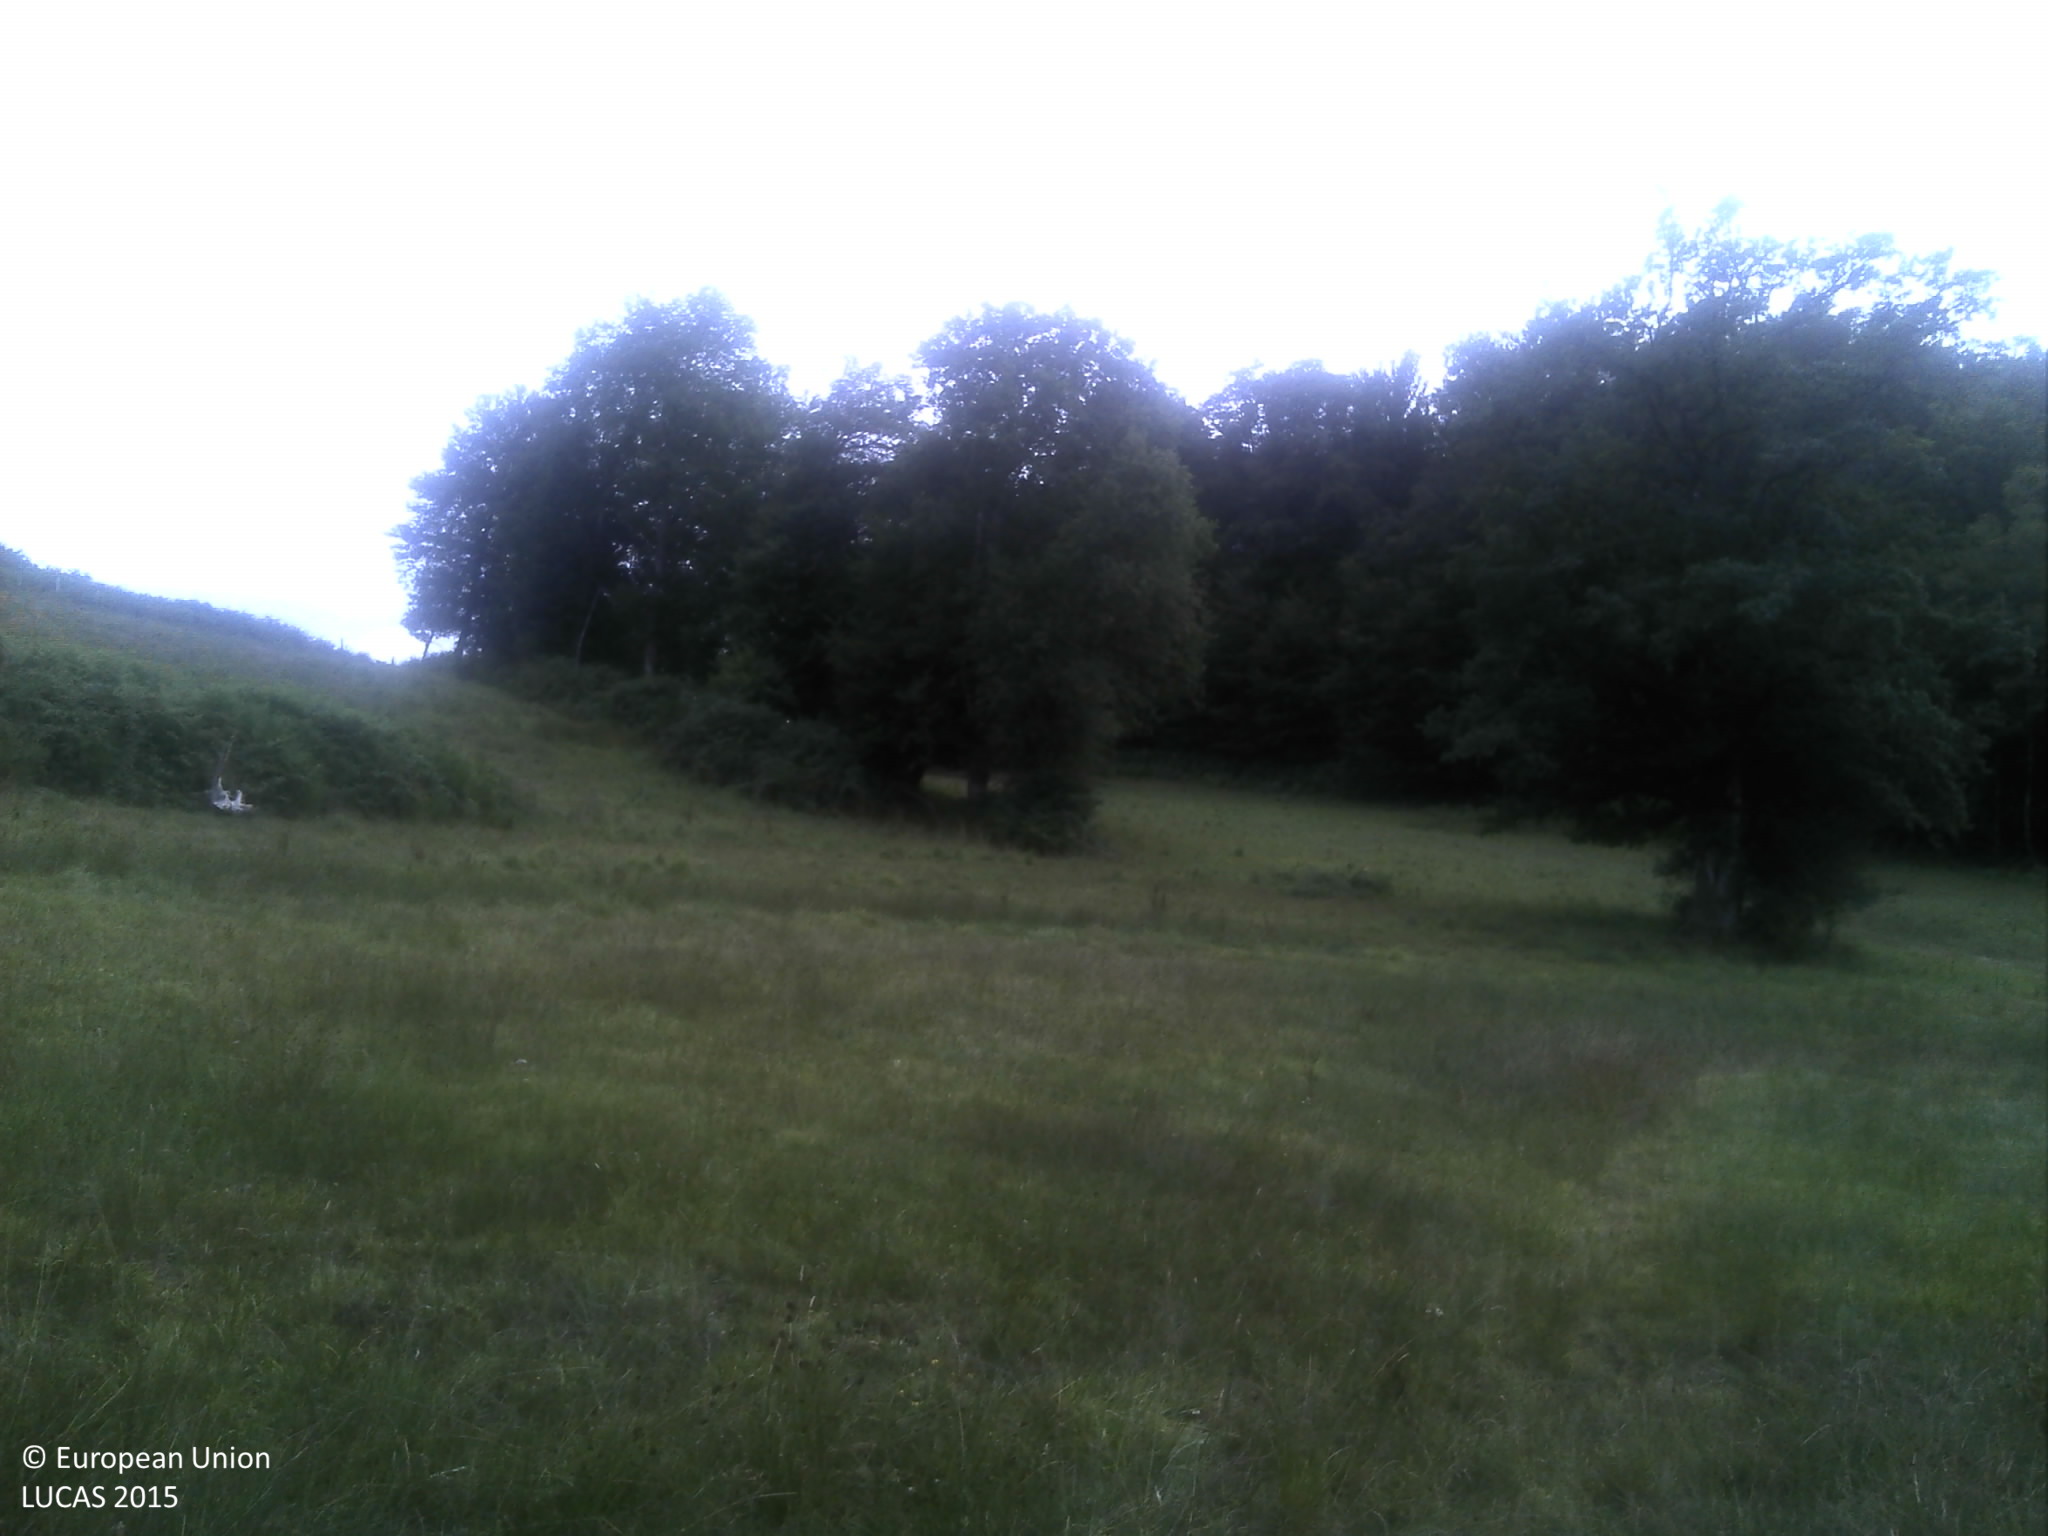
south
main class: Grassland
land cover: Grassland without tree/shrub cover
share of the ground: > 75 %
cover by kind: herbaceous plants 100 %
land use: Agriculture (excluding fallow land and kitchen gardens)
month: August
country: FR
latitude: 45.4412
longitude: 2.3146
